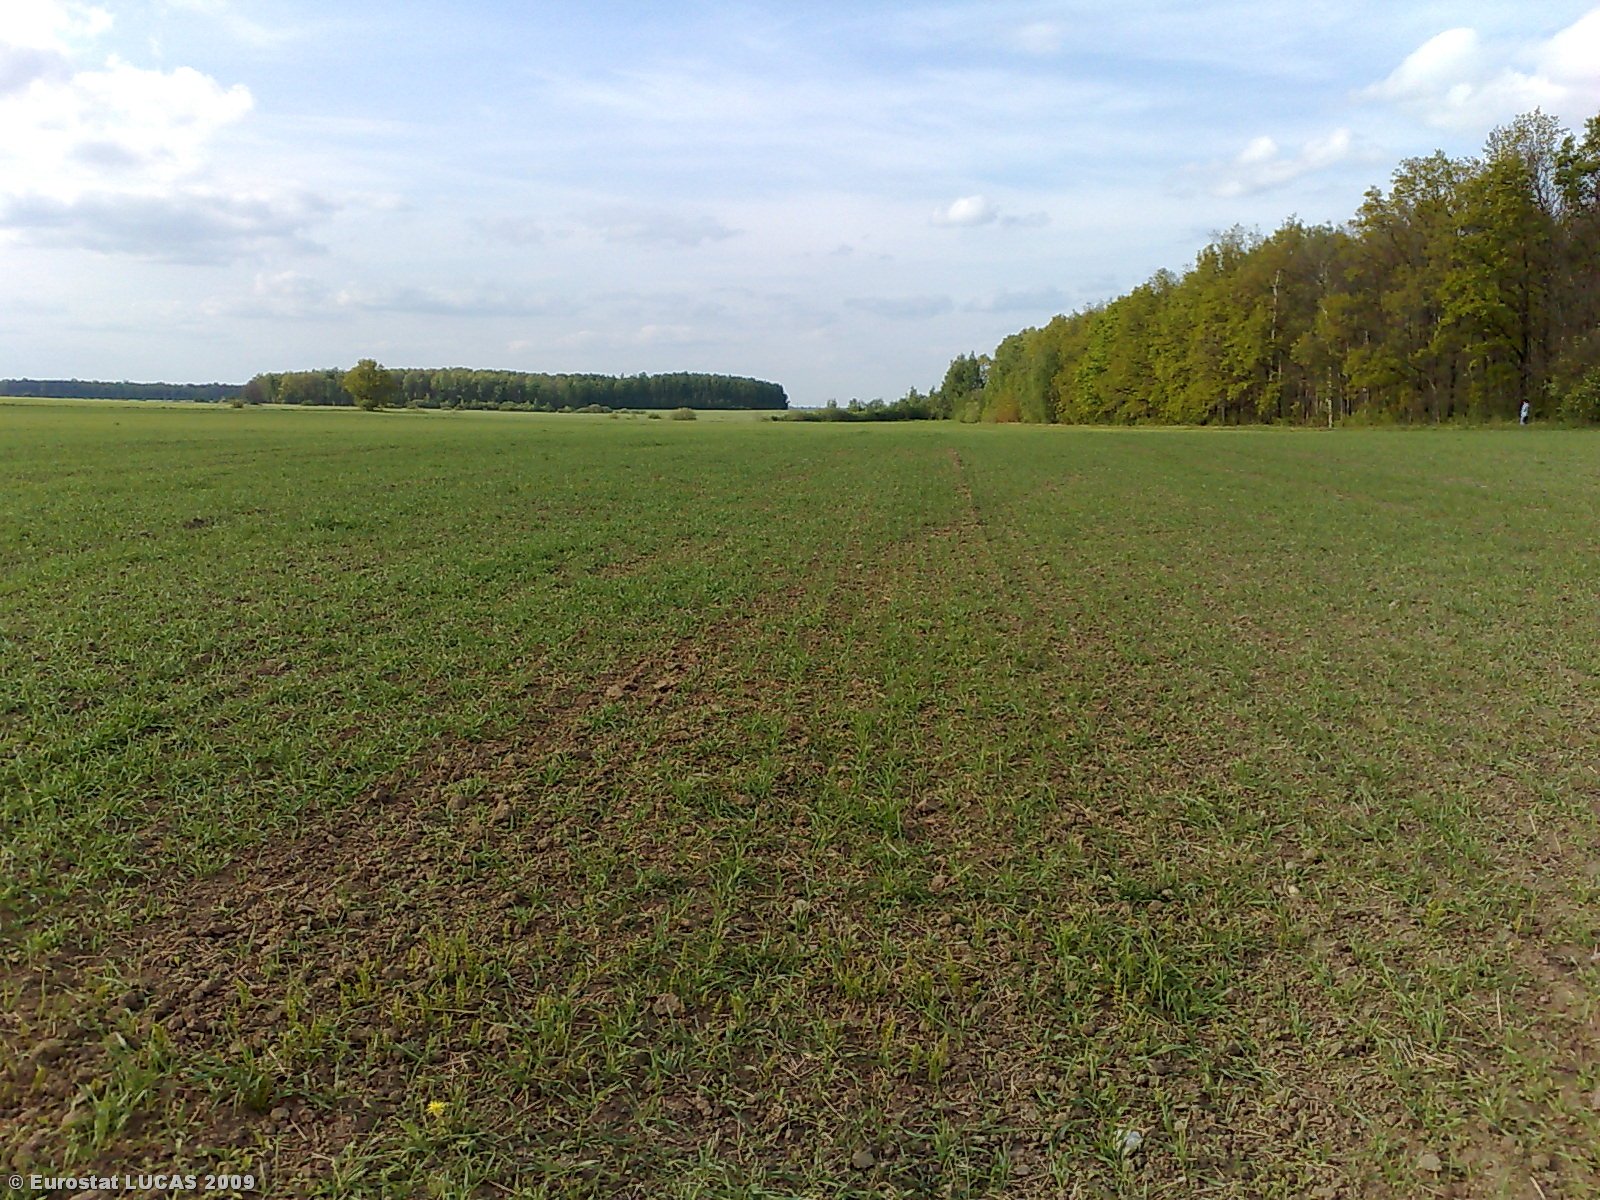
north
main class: Cropland
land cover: Barley
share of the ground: 50 - 75 %
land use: Agriculture (excluding fallow land and kitchen gardens)
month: May
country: LT
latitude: 55.8533
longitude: 23.8383
